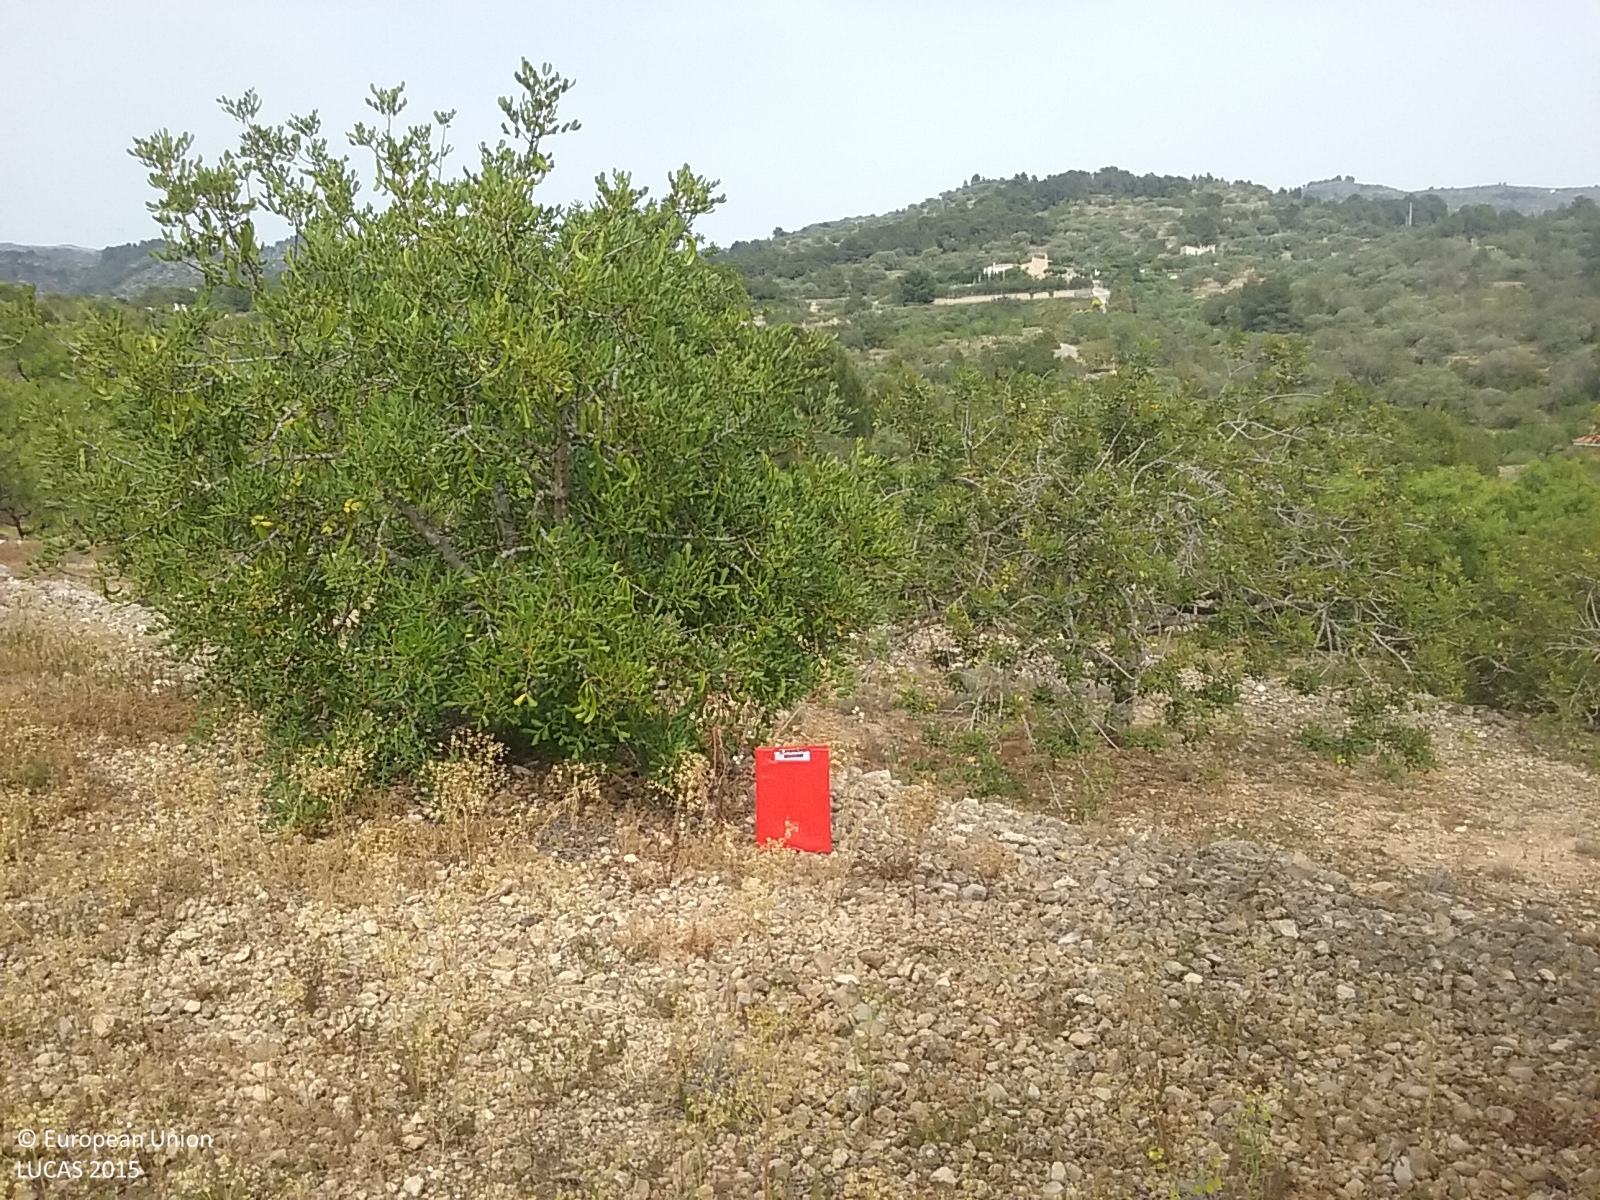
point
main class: Cropland
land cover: Nuts trees
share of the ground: 25 - 50 %
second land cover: Spontaneously vegetated surfaces
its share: 50 - 75 %
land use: Agriculture (excluding fallow land and kitchen gardens)
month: May
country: ES
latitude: 40.8288
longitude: 0.5431
